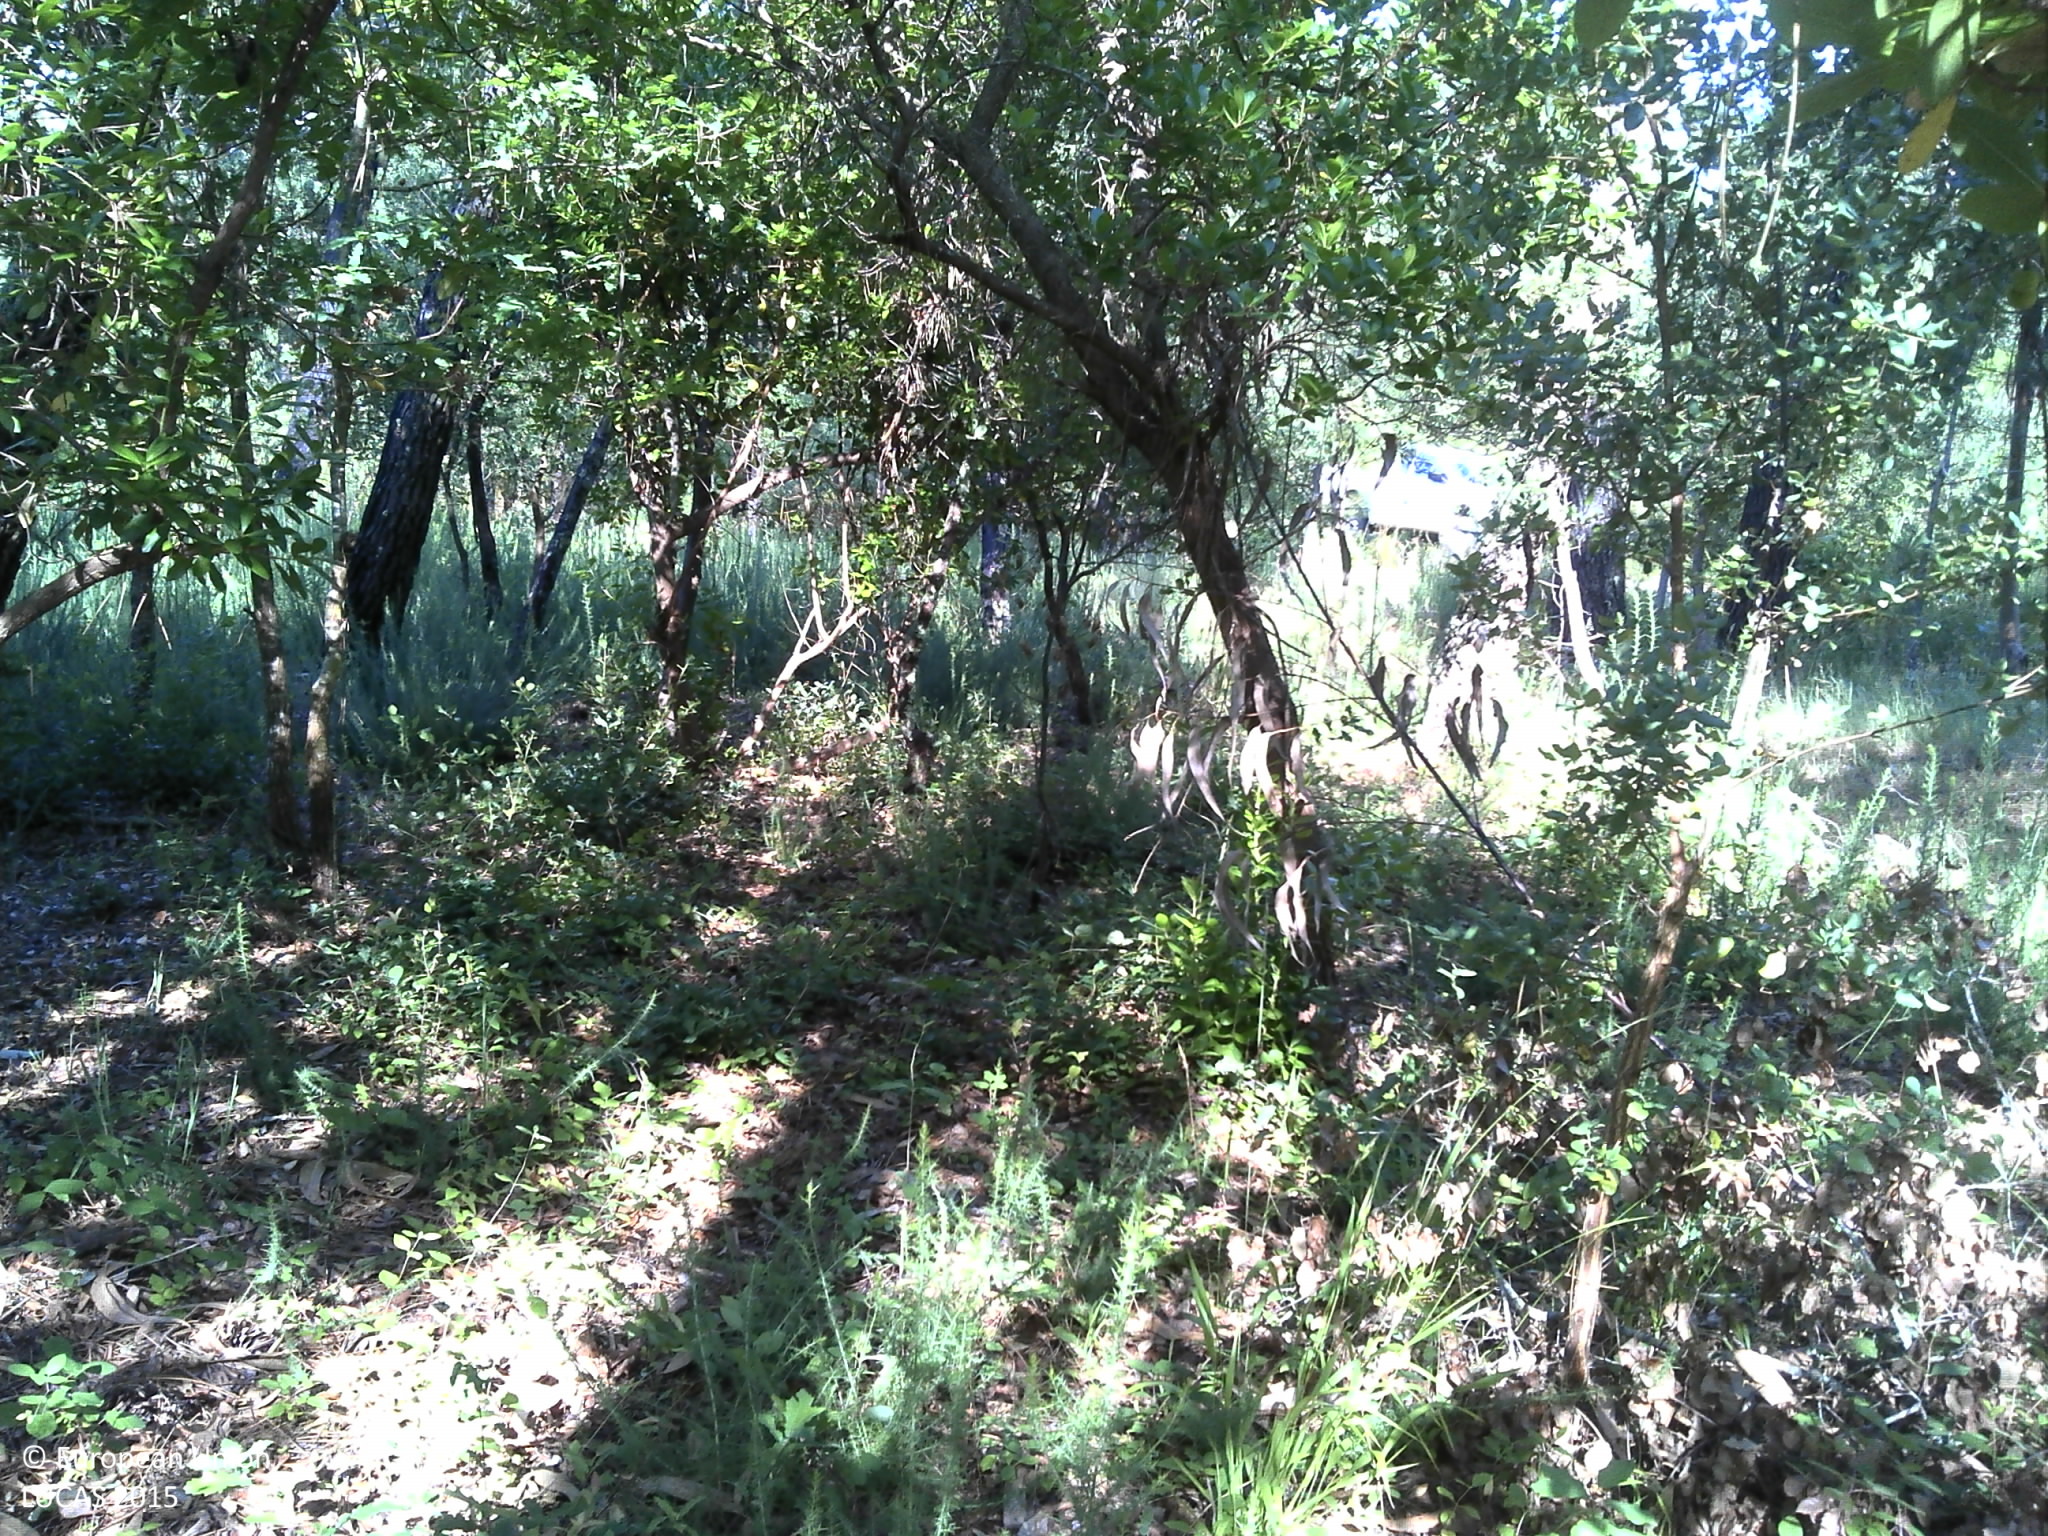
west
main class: Woodland
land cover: Pine dominated coniferous woodland
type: coniferous forest of the mediterranean region
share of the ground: 10 - 25 %
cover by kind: herbaceous plants 50 %, unconsolidated bare surface 30 %, coniferous forest trees 20 %
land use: Forestry
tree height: > 5 m
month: June
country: PT
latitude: 40.1326
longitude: -8.2323
